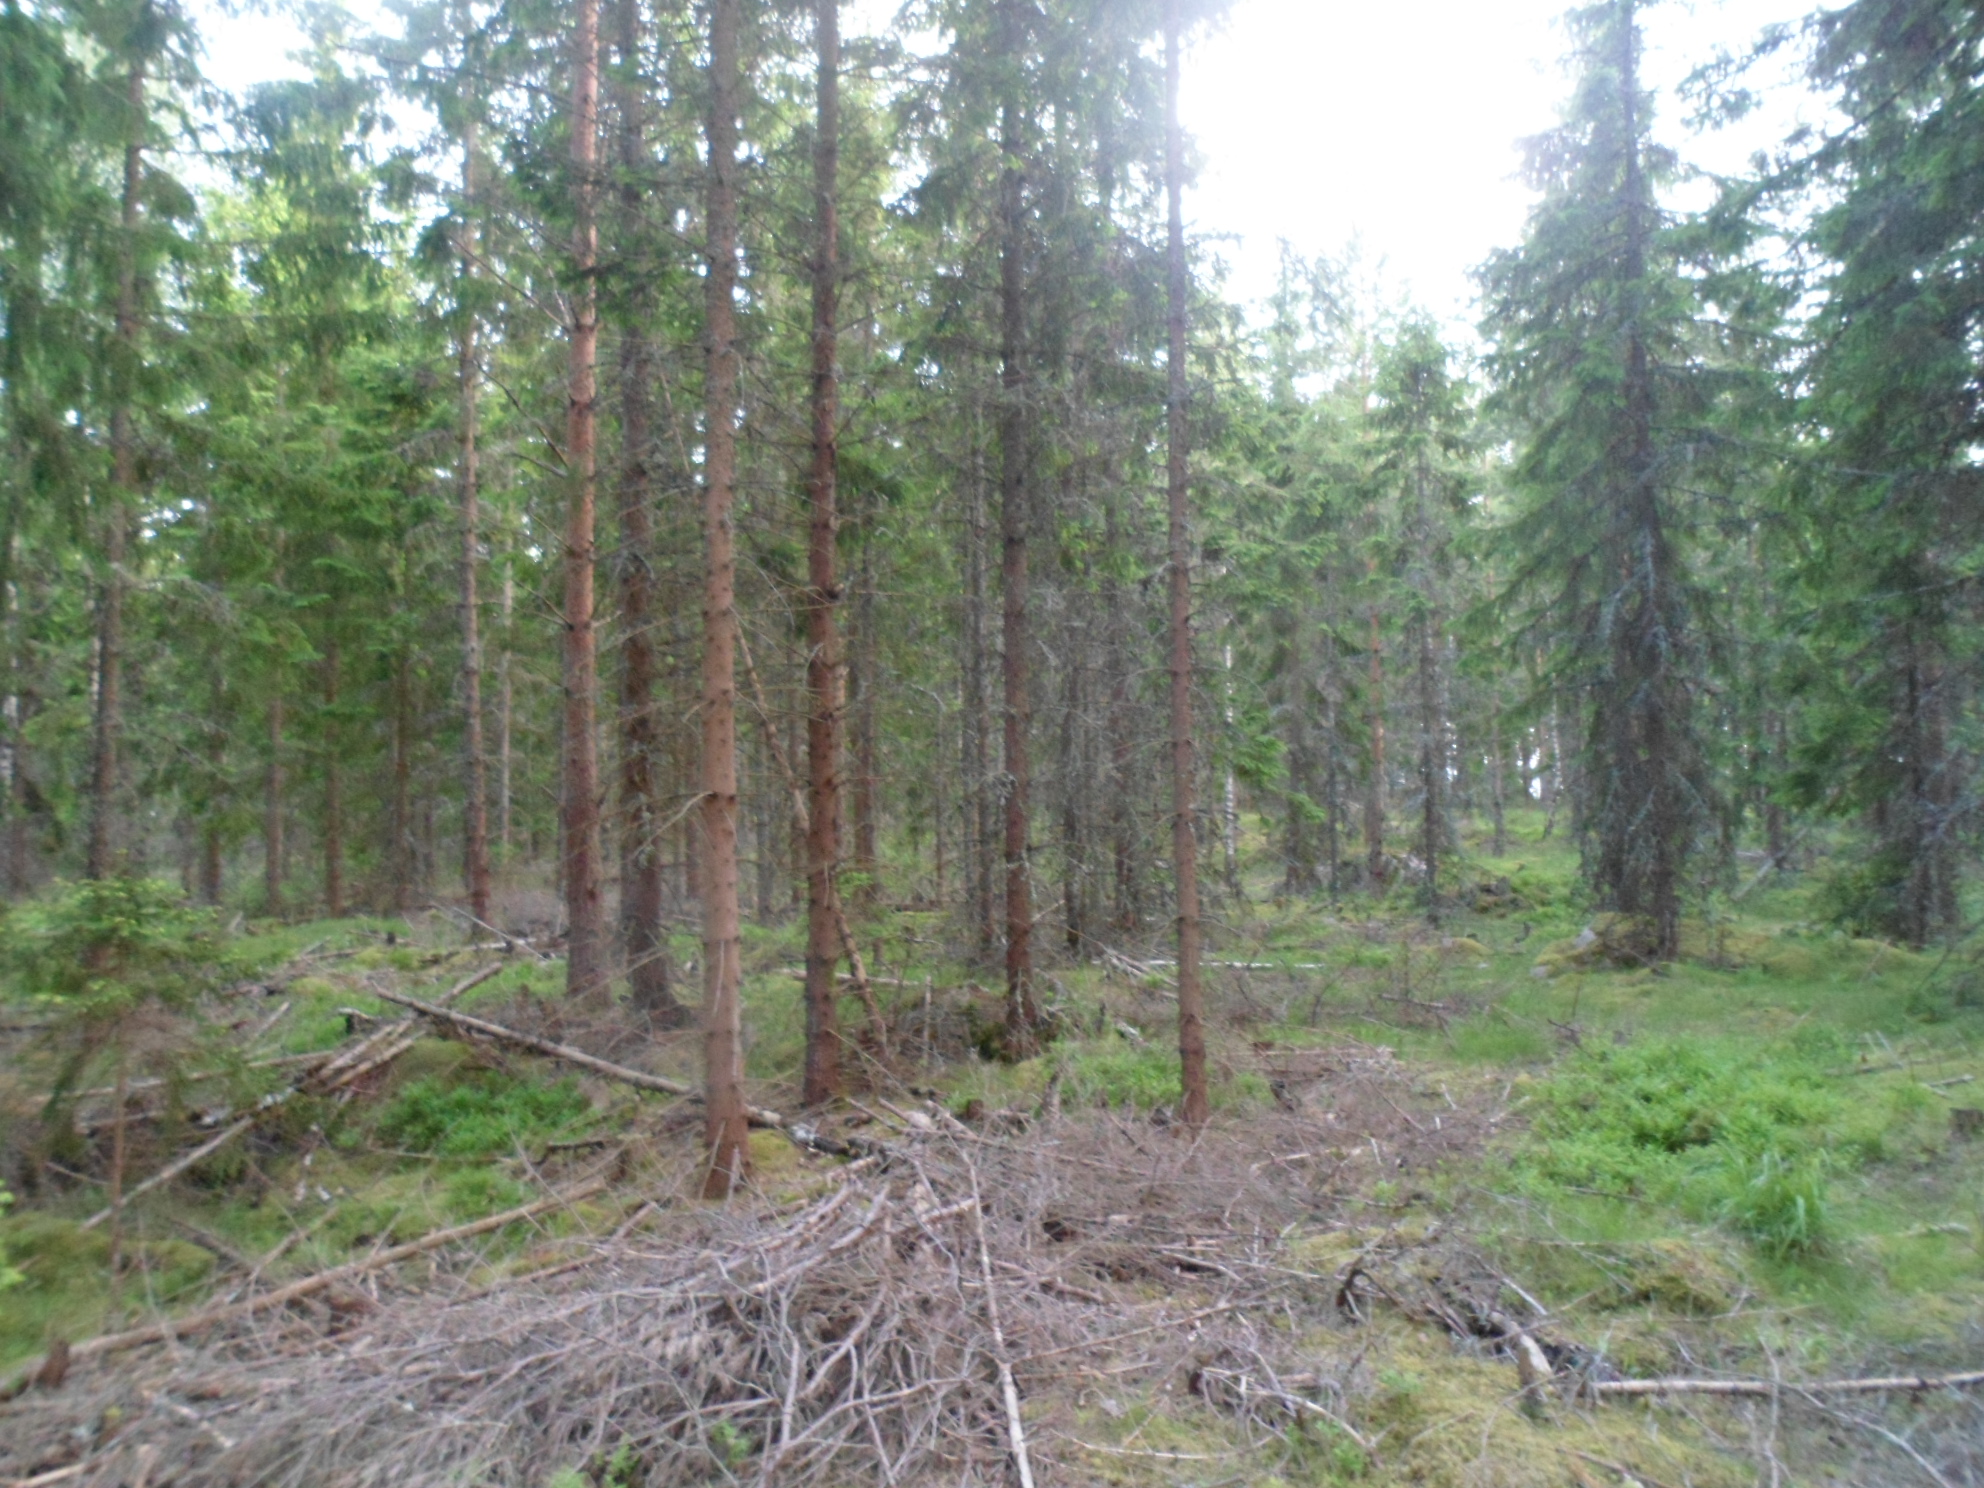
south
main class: Woodland
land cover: Pine dominated coniferous woodland
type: boreal forest
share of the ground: 50 - 75 %
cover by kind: coniferous forest trees 55 %, lichens and mosses 25 %, shrubs 20 %
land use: Forestry
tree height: > 5 m
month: June
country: SE
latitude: 57.0590
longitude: 15.5546
